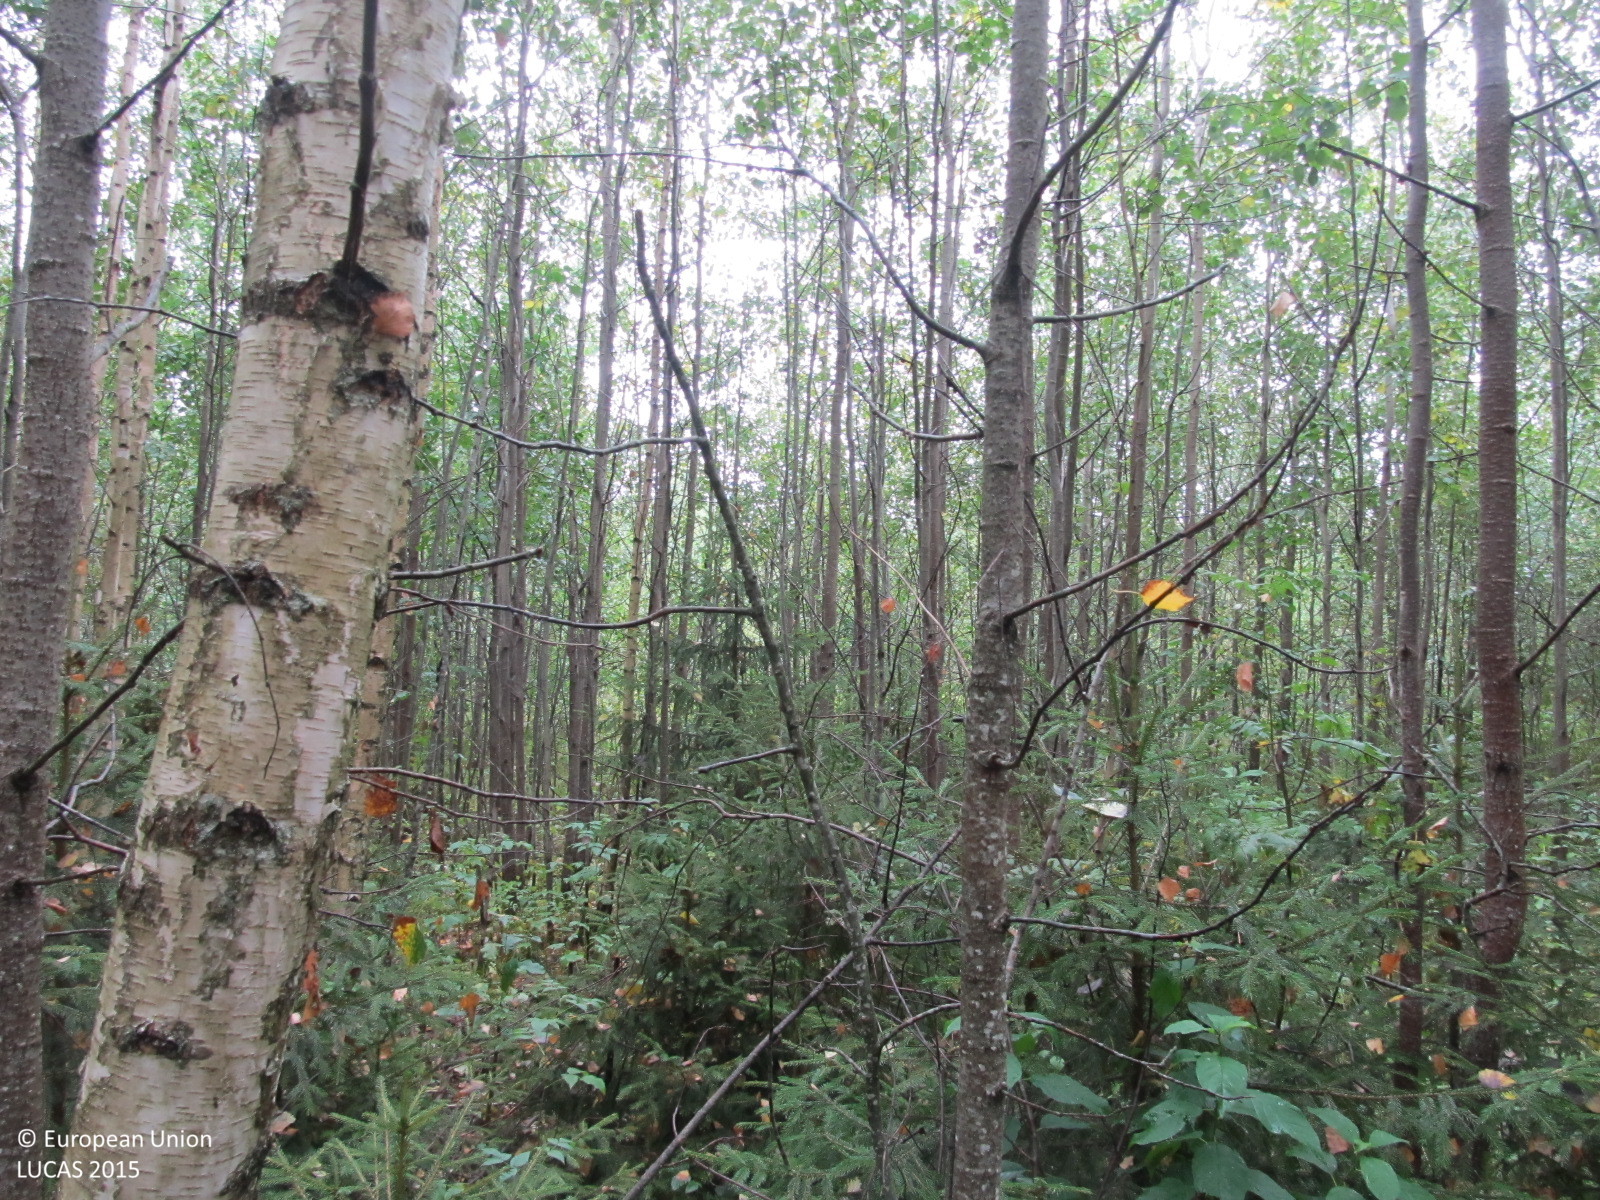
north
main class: Woodland
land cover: Broadleaved woodland
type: non-riverine alder, birch or aspen forest
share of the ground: > 75 %
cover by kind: broadleaved forest trees 75 %, coniferous forest trees 5 %, shrubs 5 %, herbaceous plants 5 %, lichens and mosses 5 %, unconsolidated bare surface 5 %
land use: Forestry
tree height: > 5 m
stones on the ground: < 10 %
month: September
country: LT
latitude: 55.9883
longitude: 22.9062
